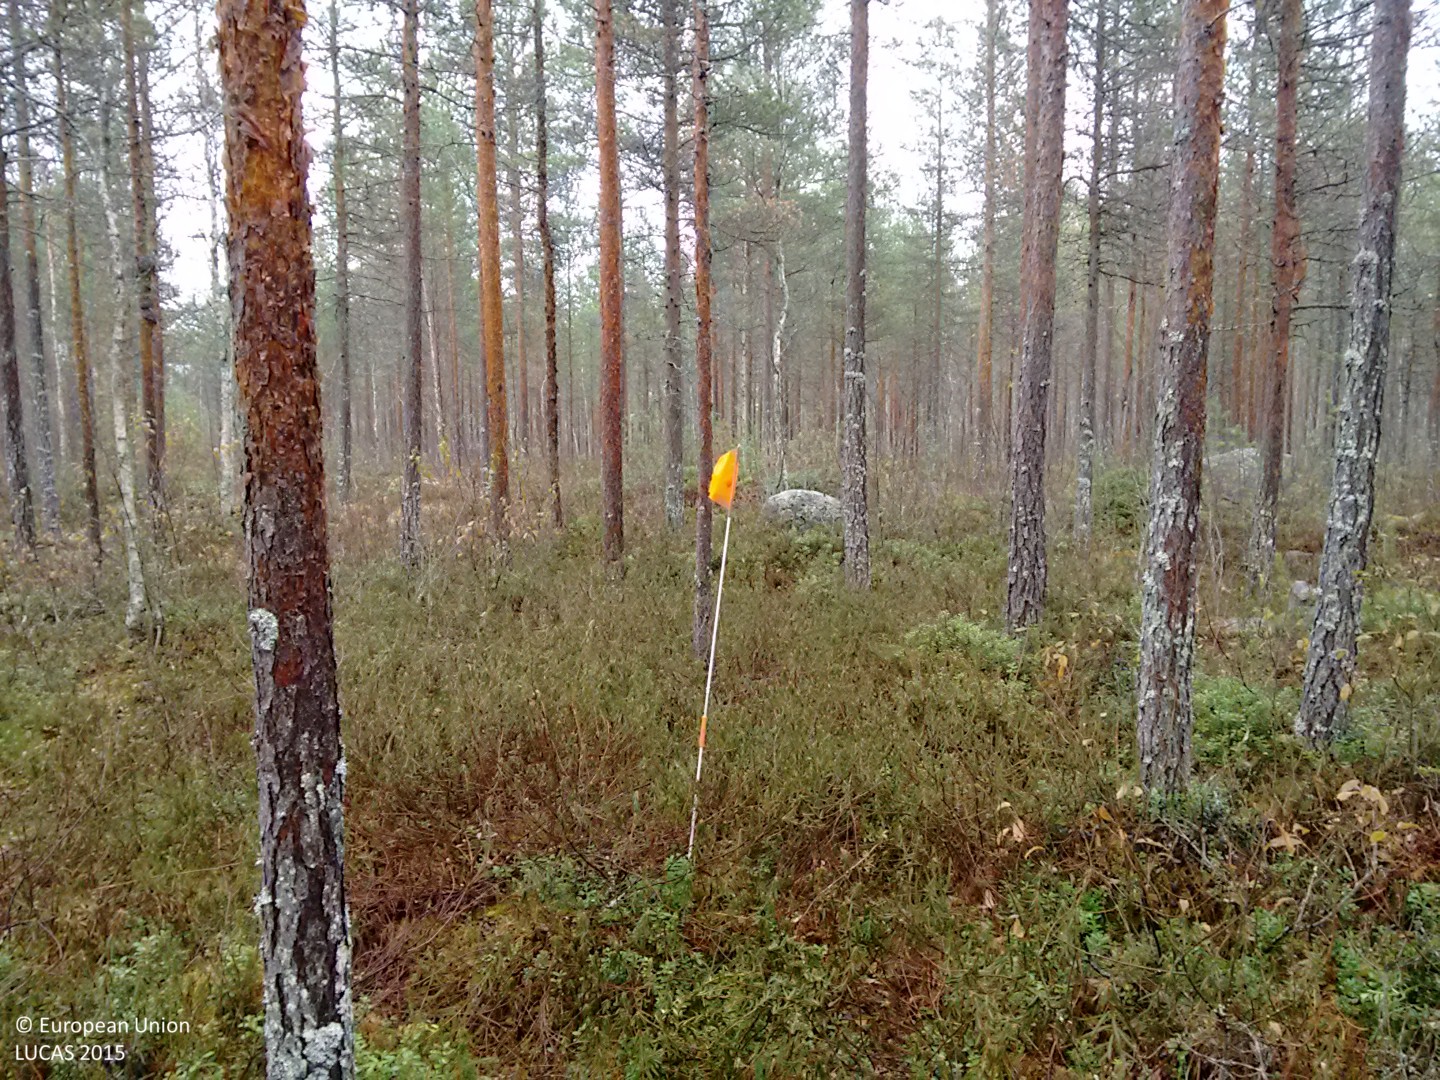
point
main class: Woodland
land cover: Pine dominated coniferous woodland
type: boreal forest
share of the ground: 50 - 75 %
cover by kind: coniferous forest trees 70 %, shrubs 25 %, lichens and mosses 5 %
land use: Forestry
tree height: > 5 m
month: October
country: FI
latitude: 64.6550
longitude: 24.8346
